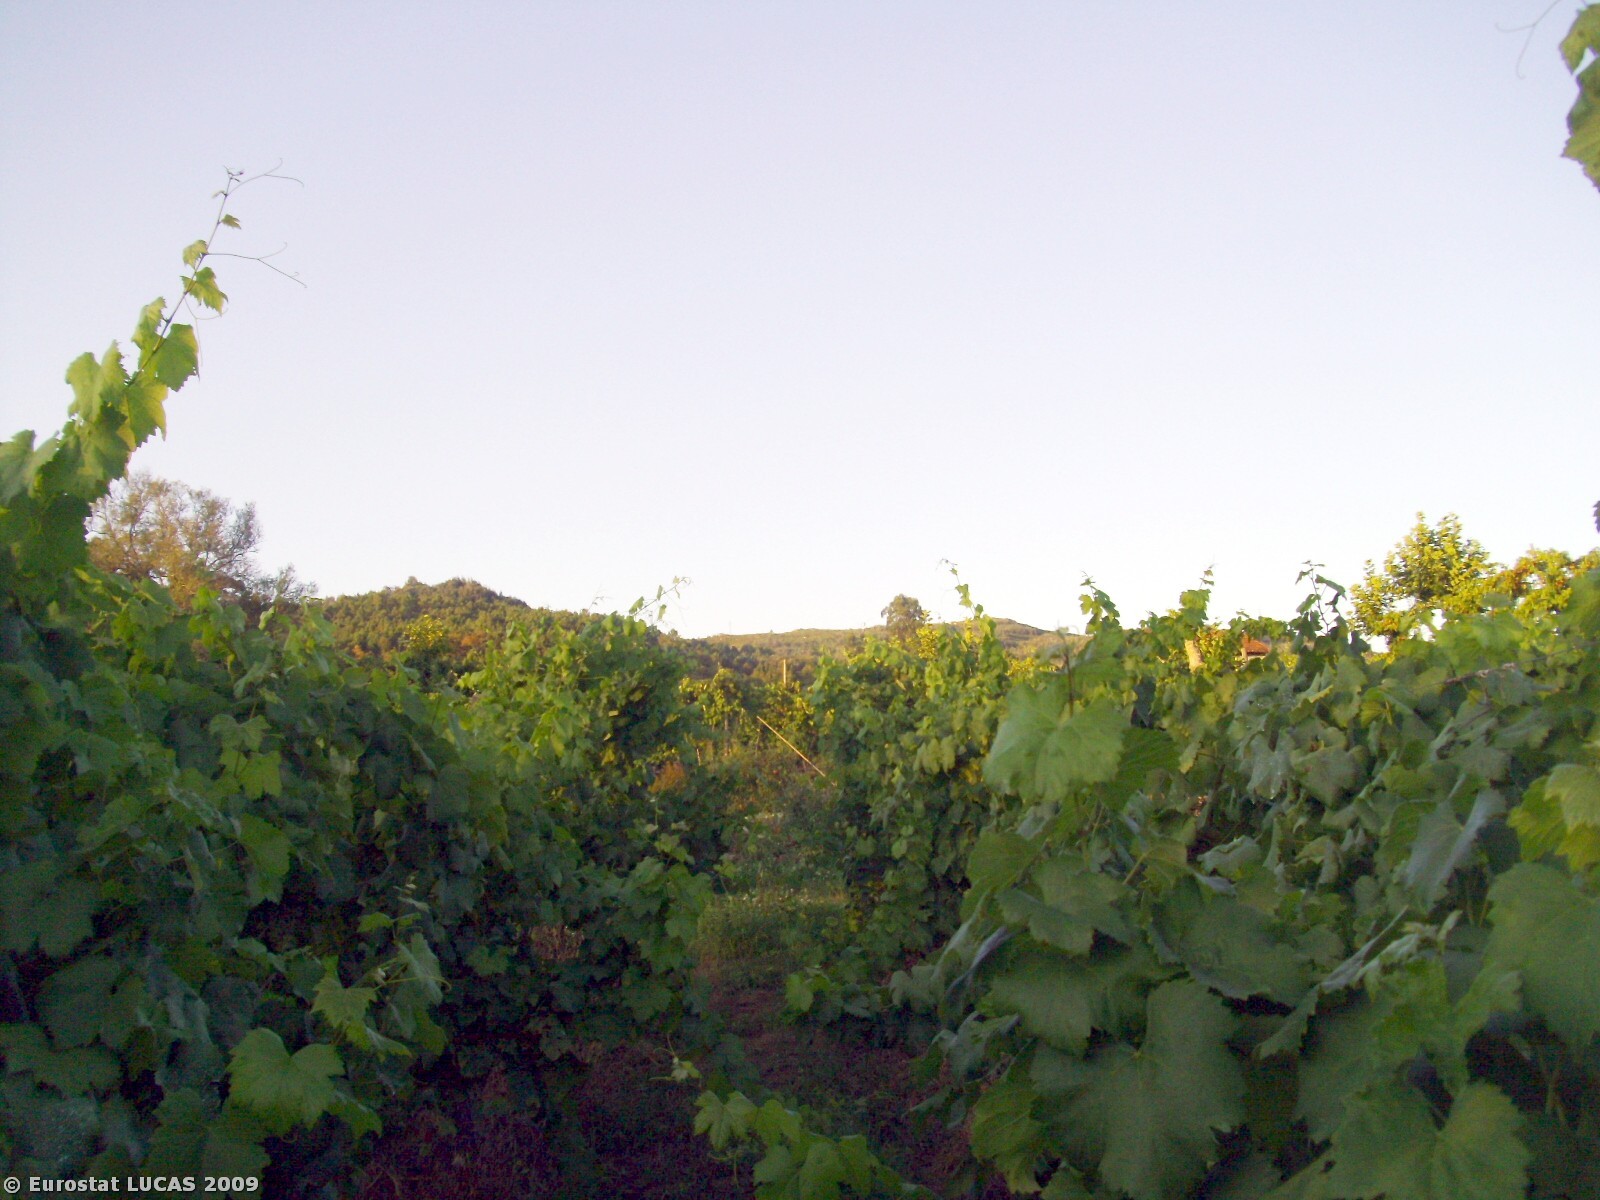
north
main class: Cropland
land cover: Vineyards
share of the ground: 50 - 75 %
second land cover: Spontaneously vegetated surfaces
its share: 25 - 50 %
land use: Agriculture (excluding fallow land and kitchen gardens)
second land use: Unused
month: August
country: PT
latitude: 41.5262
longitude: -7.8868
